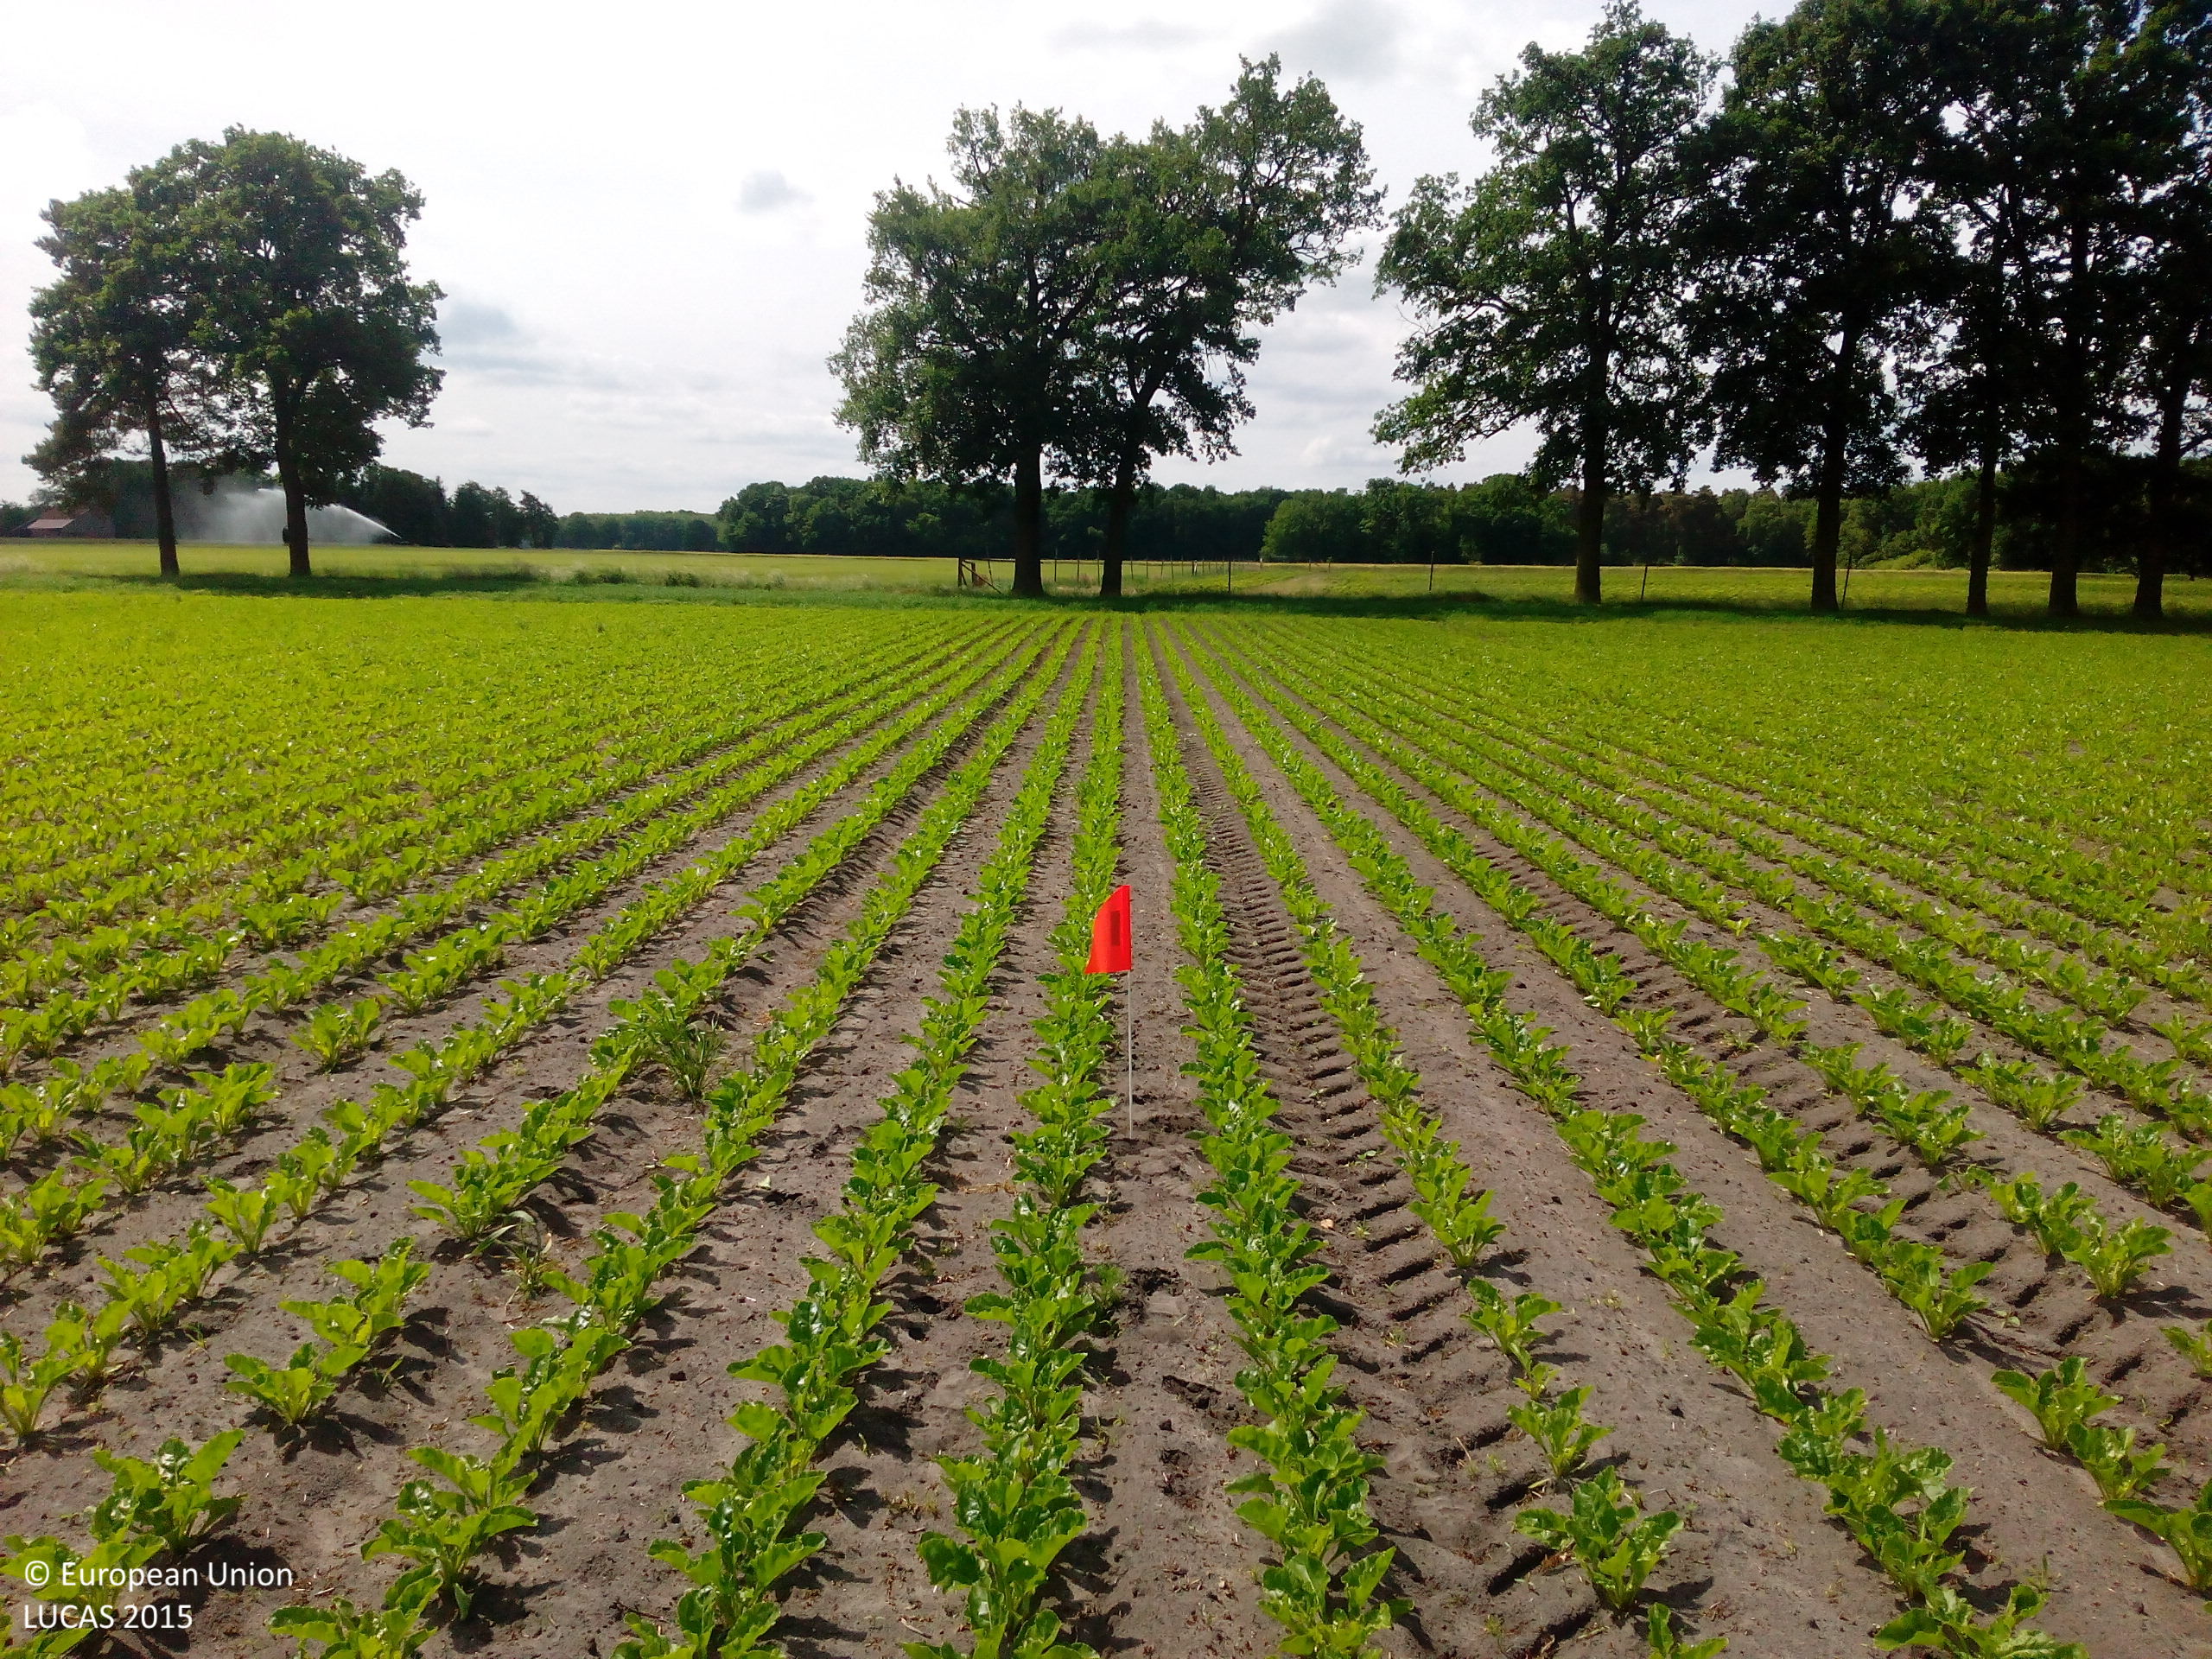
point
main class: Cropland
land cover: Sugar beet
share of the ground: < 10 %
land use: Agriculture (excluding fallow land and kitchen gardens)
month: June
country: DE
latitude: 52.5389
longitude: 10.2800
